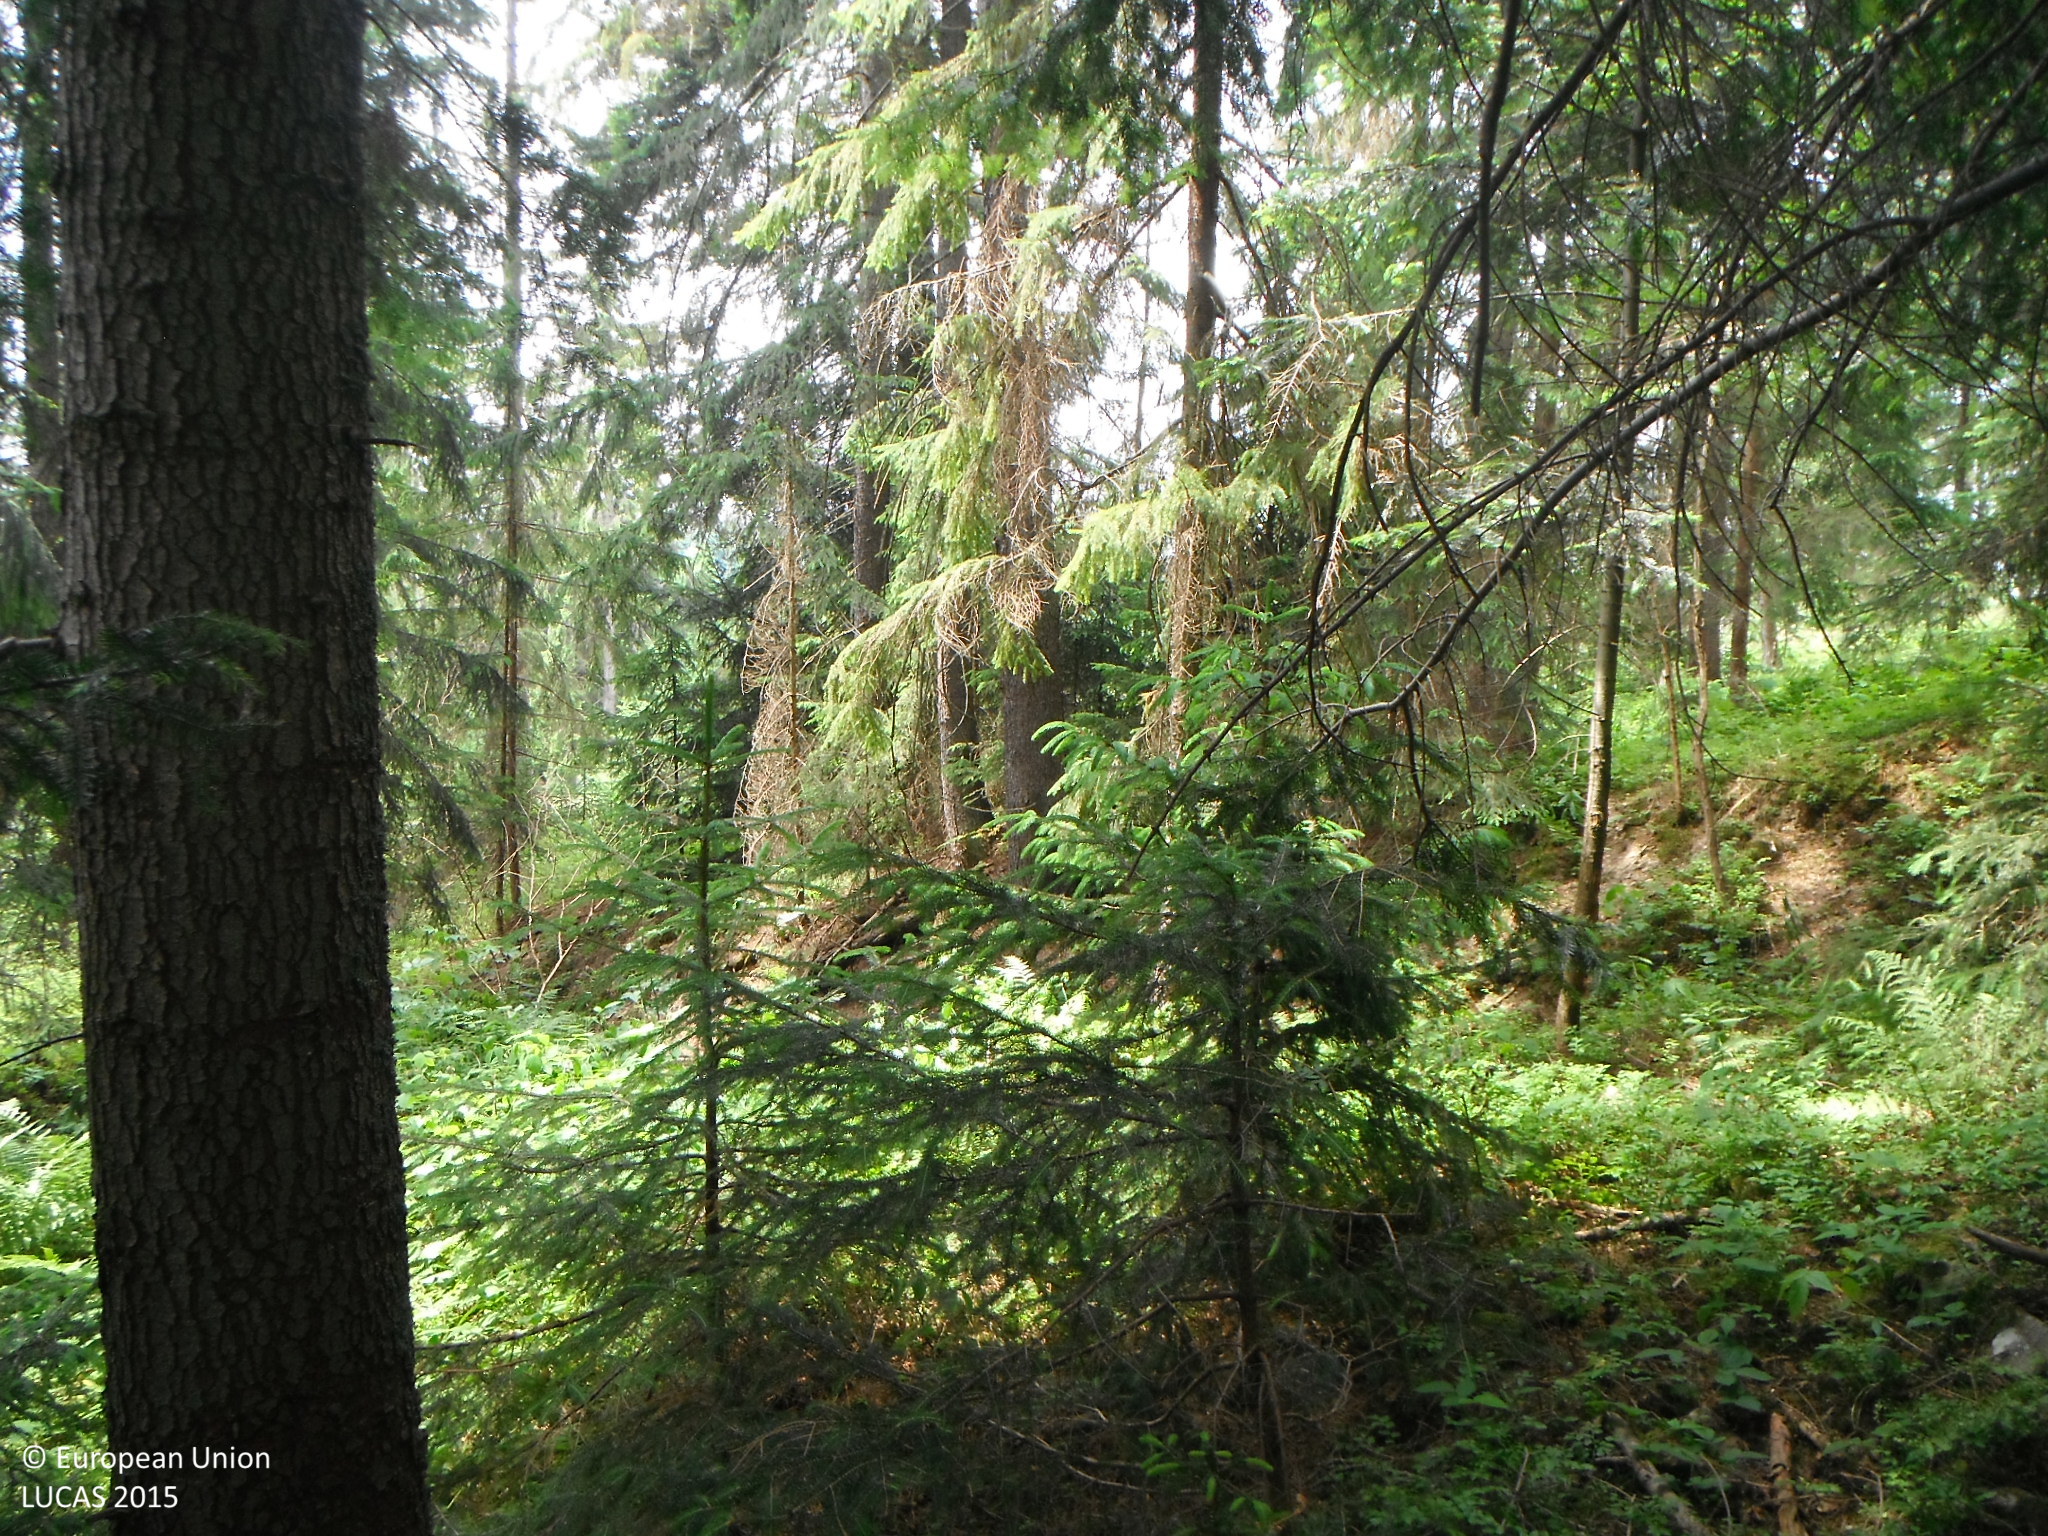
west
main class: Woodland
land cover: Spruce dominated coniferous woodland
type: alpine coniferous forest
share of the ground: > 75 %
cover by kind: coniferous forest trees 95 %, herbaceous plants 5 %
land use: Forestry
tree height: > 5 m
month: July
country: SK
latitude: 49.5115
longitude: 19.5430
